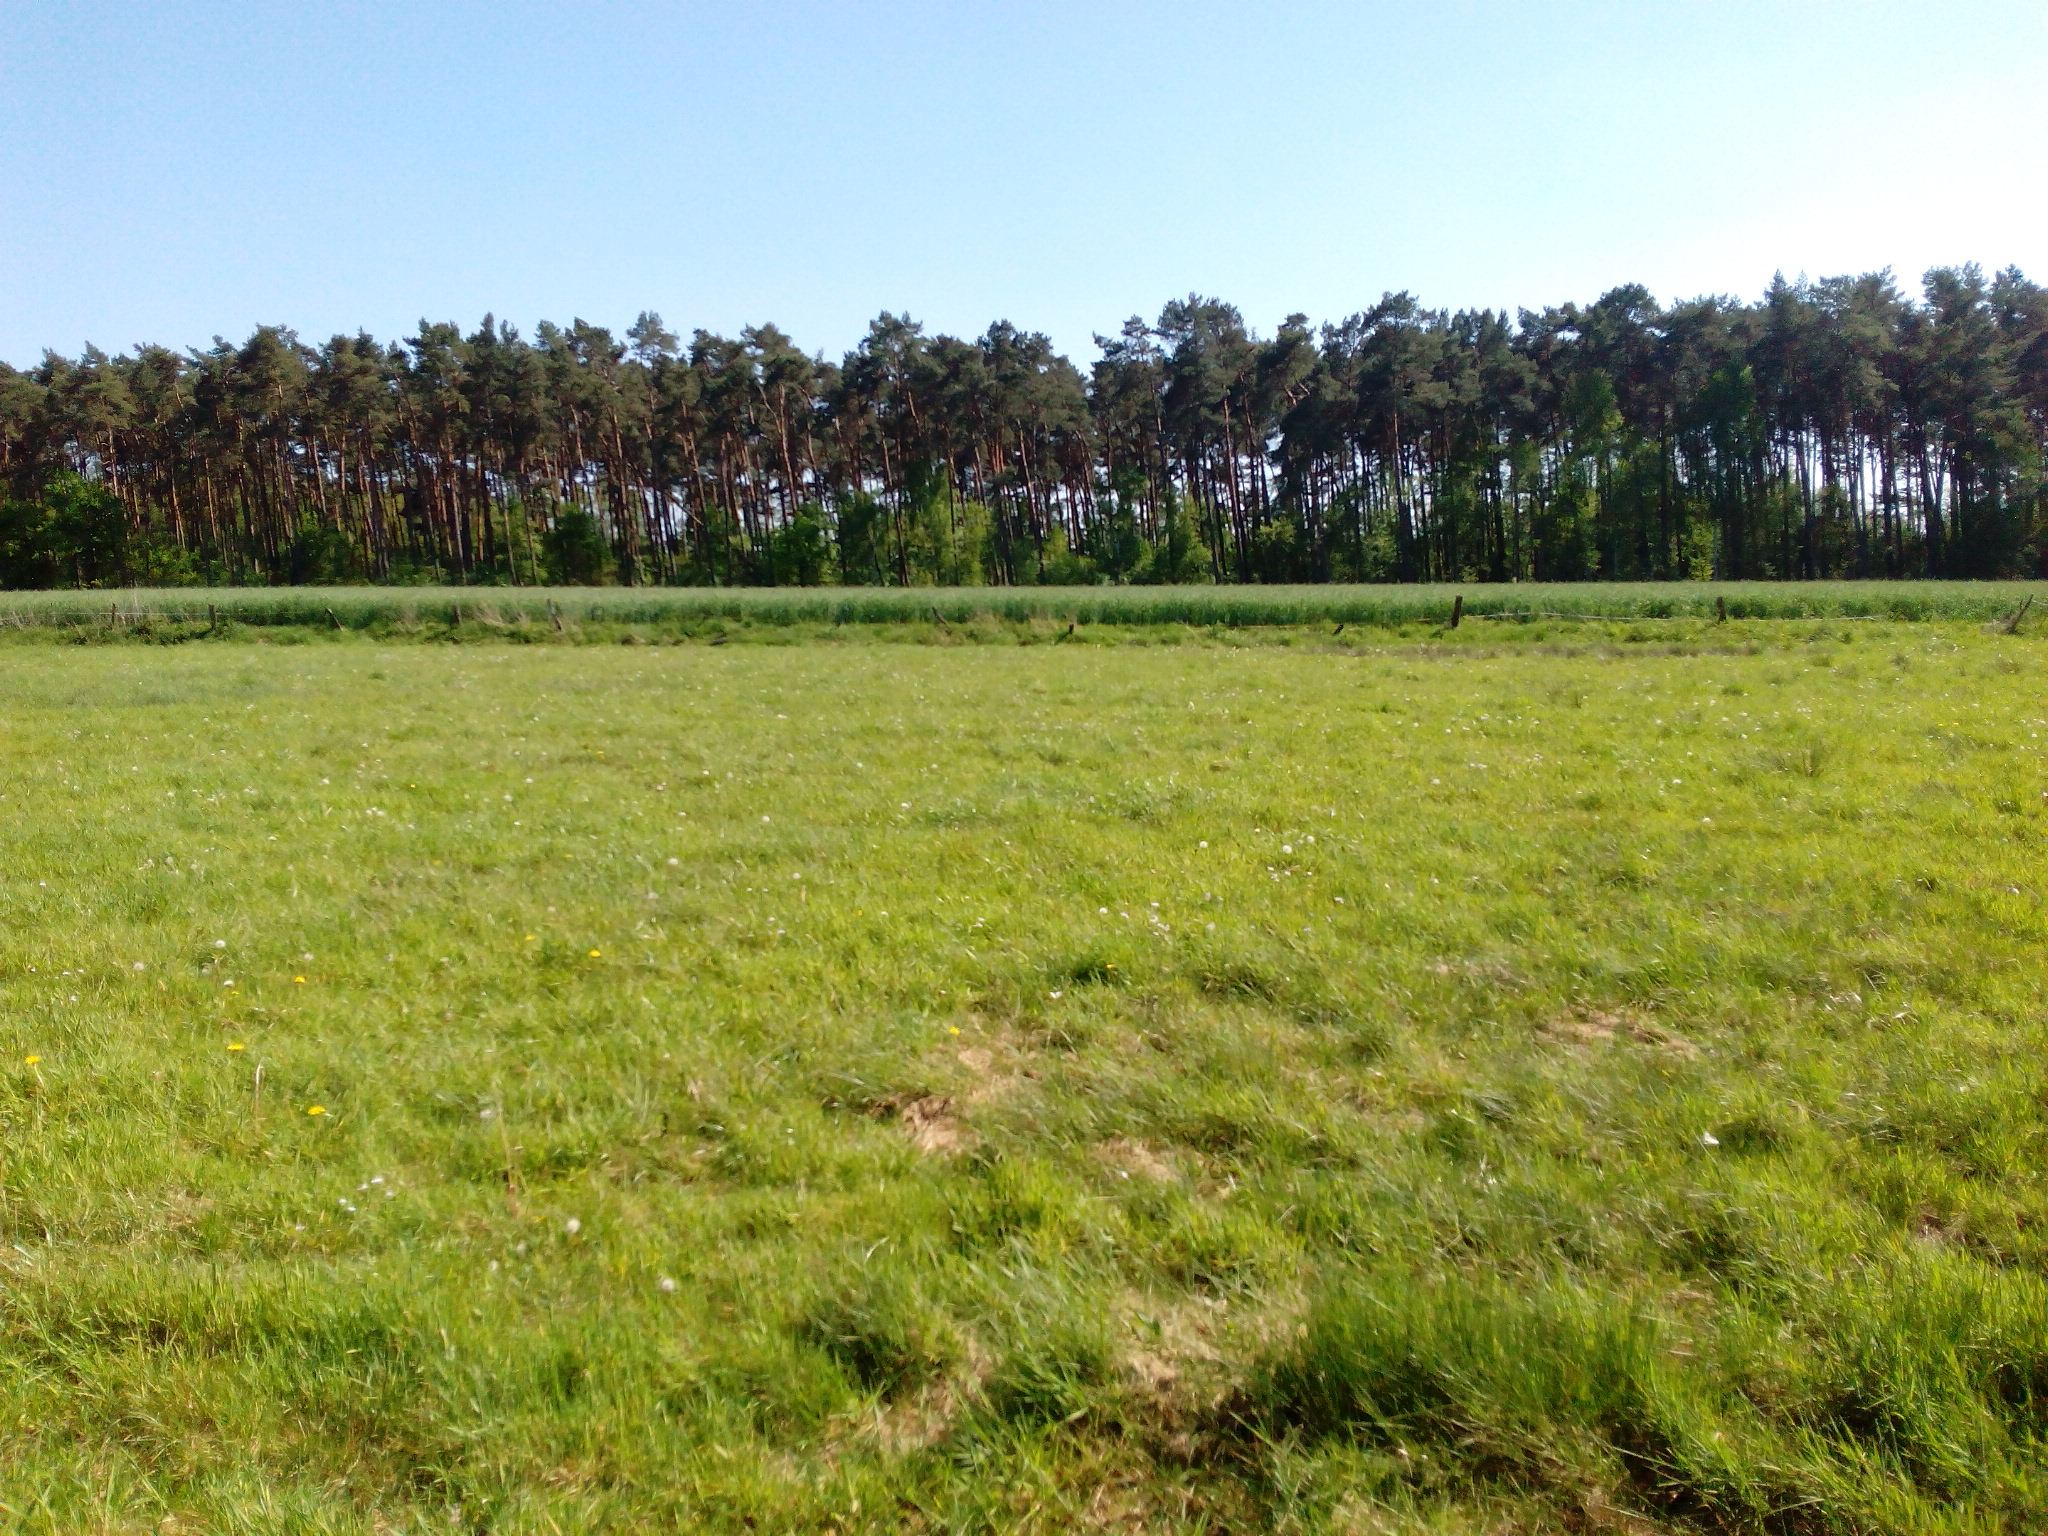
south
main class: Grassland
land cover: Grassland without tree/shrub cover
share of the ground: > 75 %
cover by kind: herbaceous plants 100 %
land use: Agriculture (excluding fallow land and kitchen gardens)
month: May
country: DE
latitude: 52.5565
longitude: 9.6019
